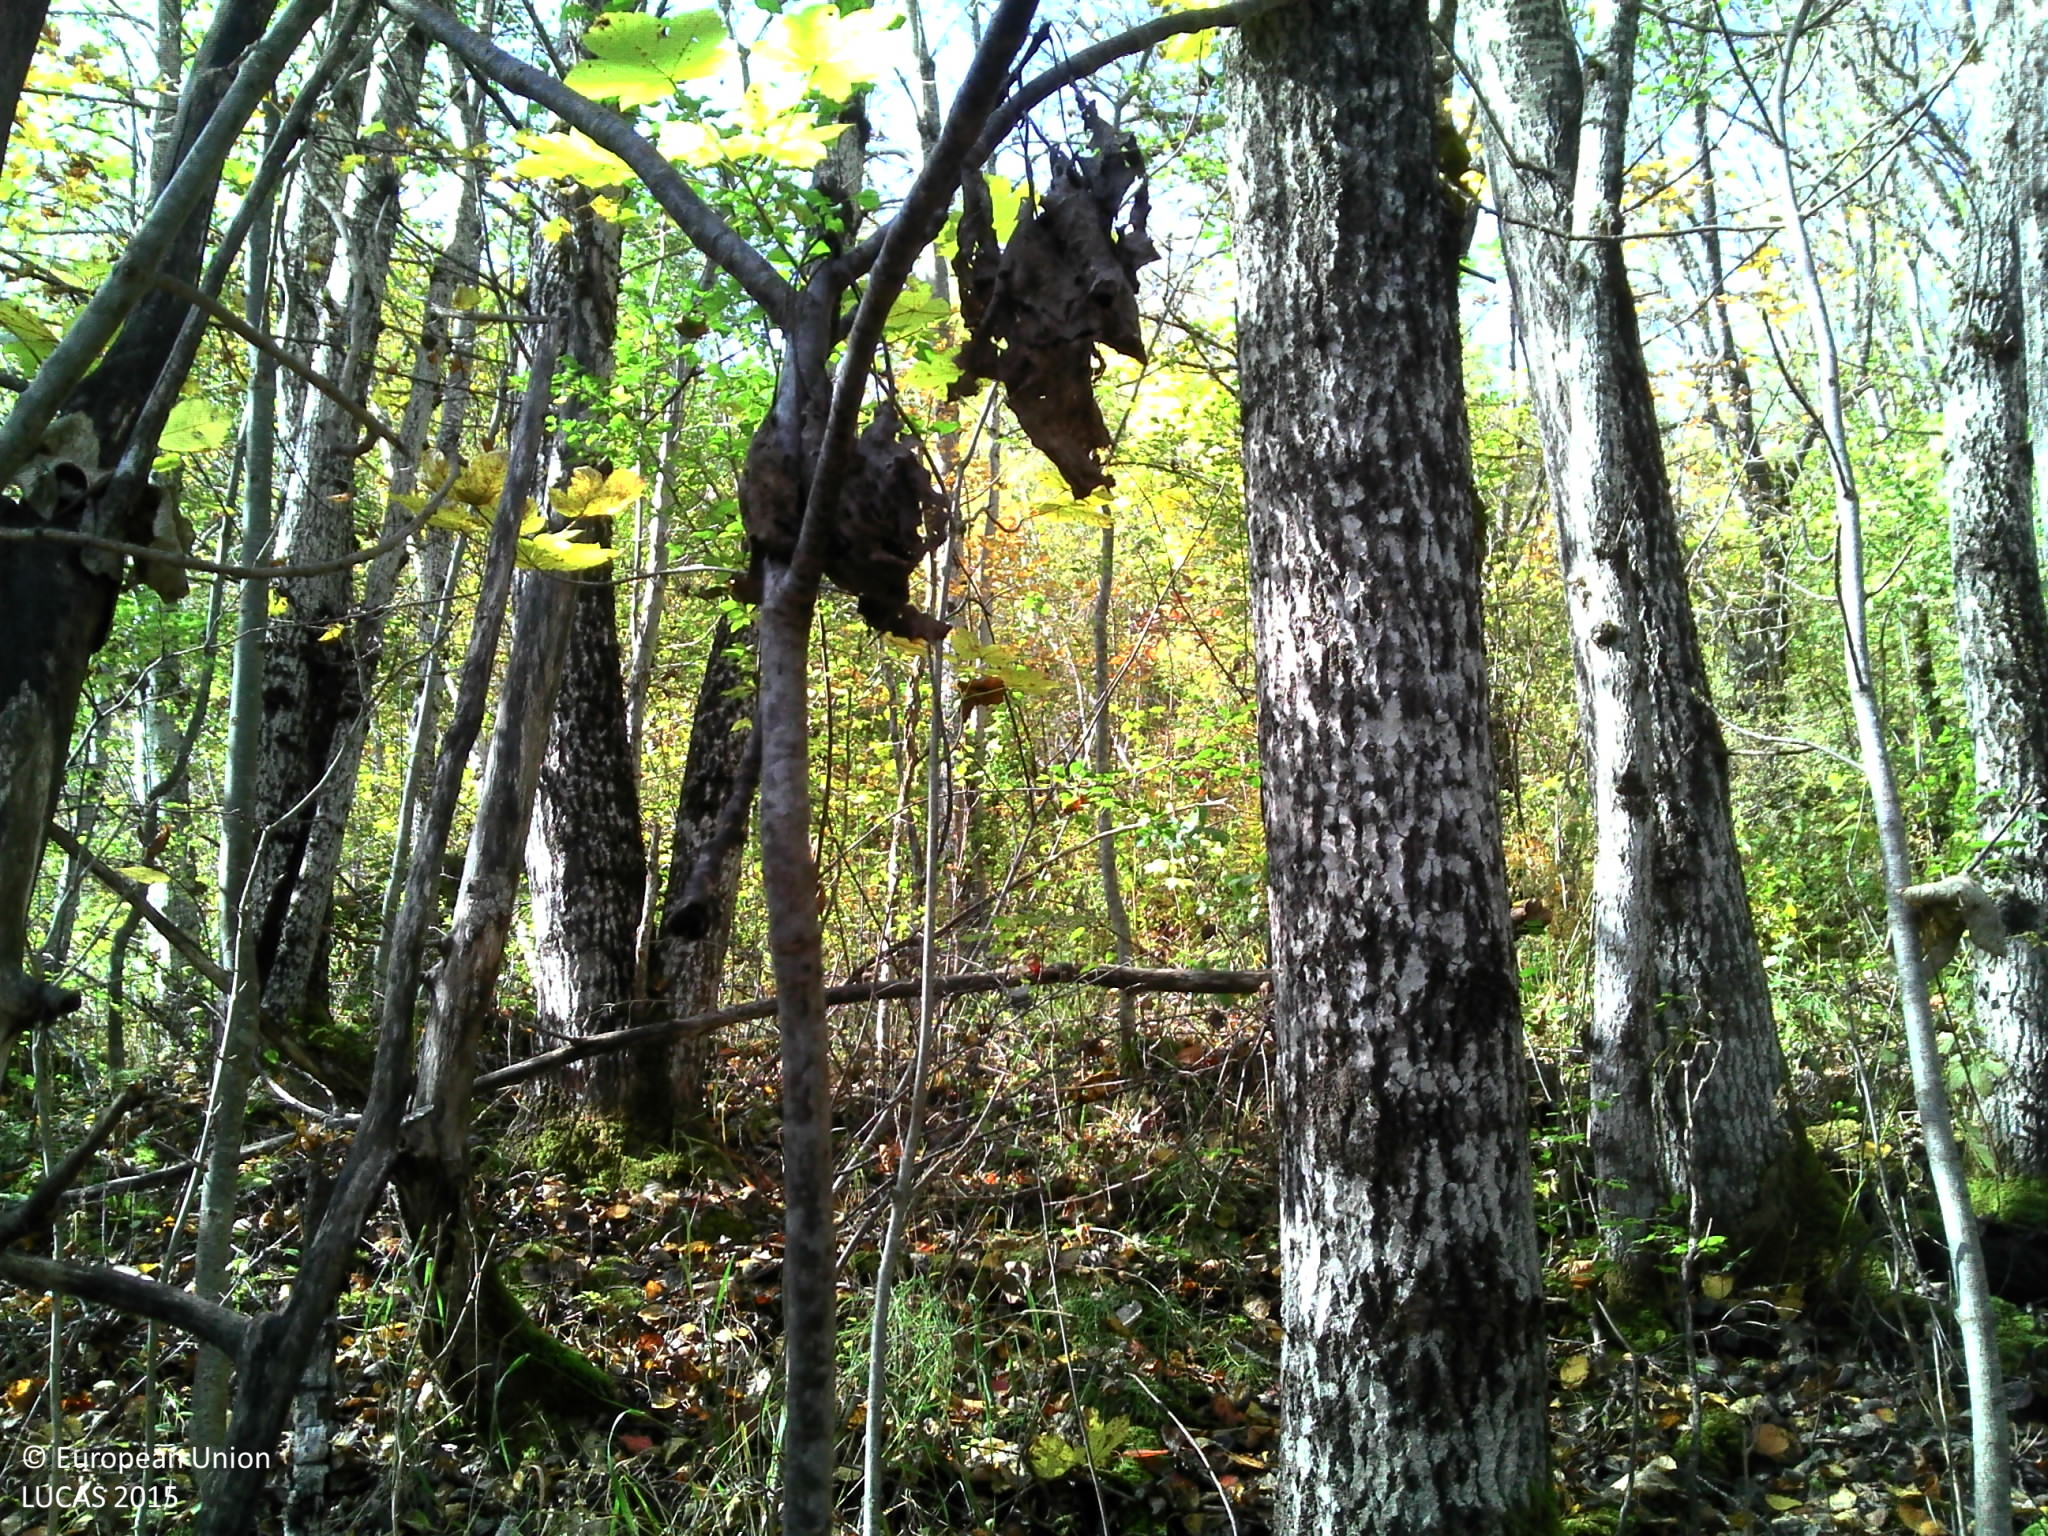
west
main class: Woodland
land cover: Broadleaved woodland
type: mesophytic deciduous forest
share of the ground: > 75 %
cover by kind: broadleaved forest trees 80 %, unconsolidated bare surface 10 %, shrubs 5 %, lichens and mosses 5 %
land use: Forestry
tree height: > 5 m
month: October
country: FR
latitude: 45.2924
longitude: 6.2181
